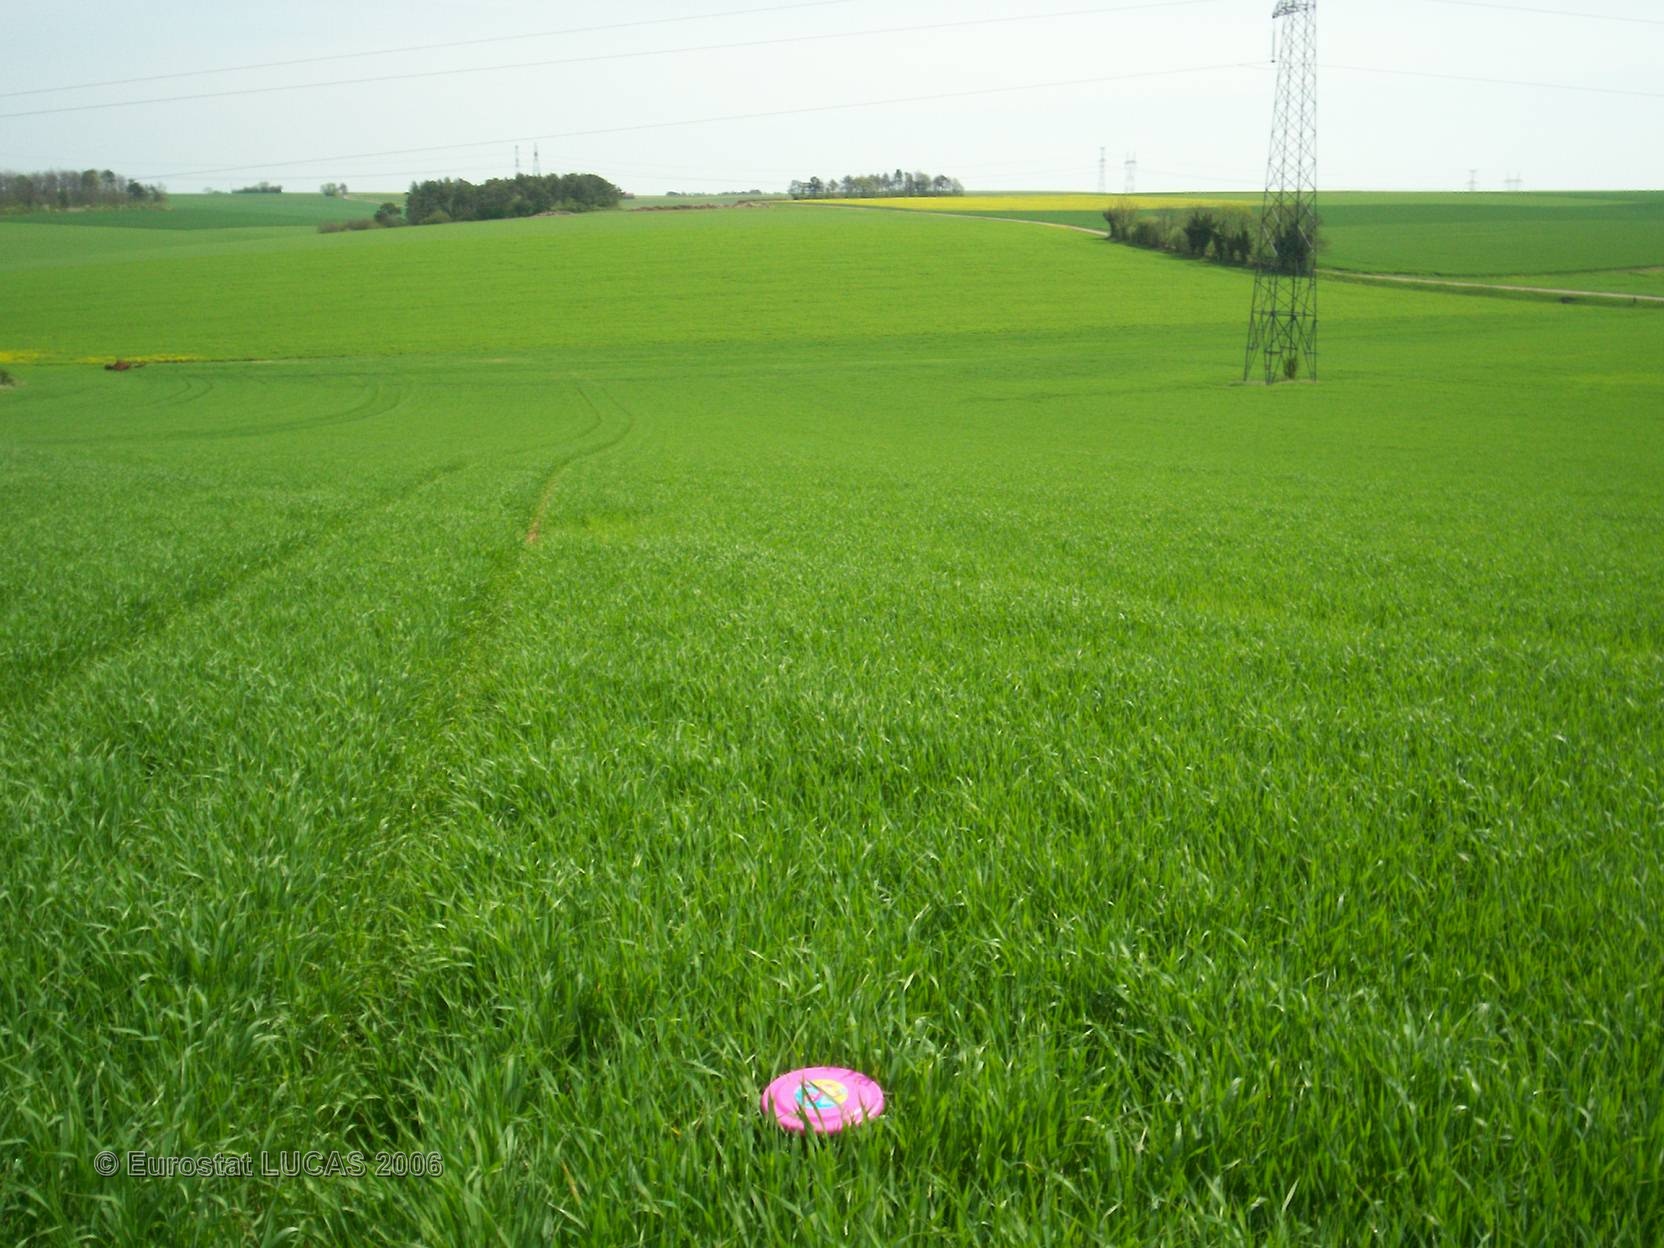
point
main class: Cropland
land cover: Barley
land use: Agriculture (excluding fallow land and kitchen gardens)
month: May
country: FR
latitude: 47.6188
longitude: 4.5305
